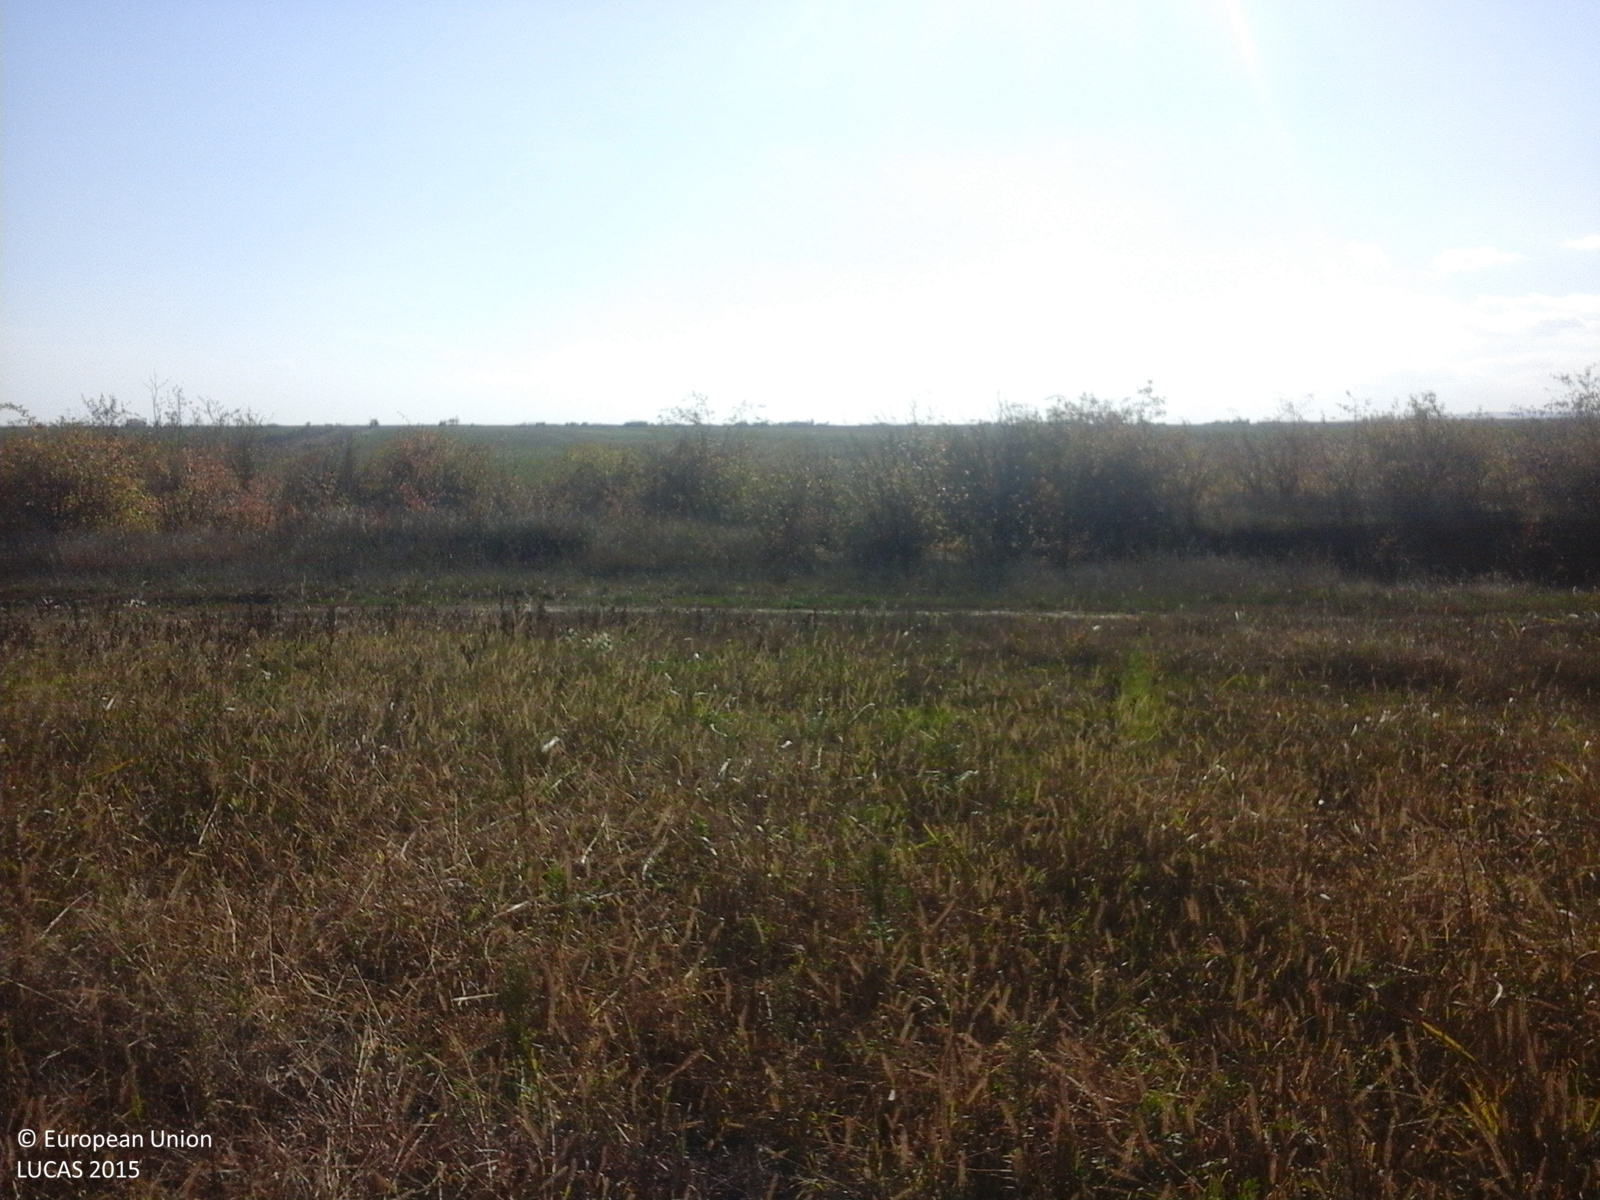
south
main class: Grassland
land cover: Spontaneously vegetated surfaces
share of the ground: > 75 %
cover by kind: herbaceous plants 100 %
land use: Fallow land
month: October
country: RO
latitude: 45.6996
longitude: 27.0834
